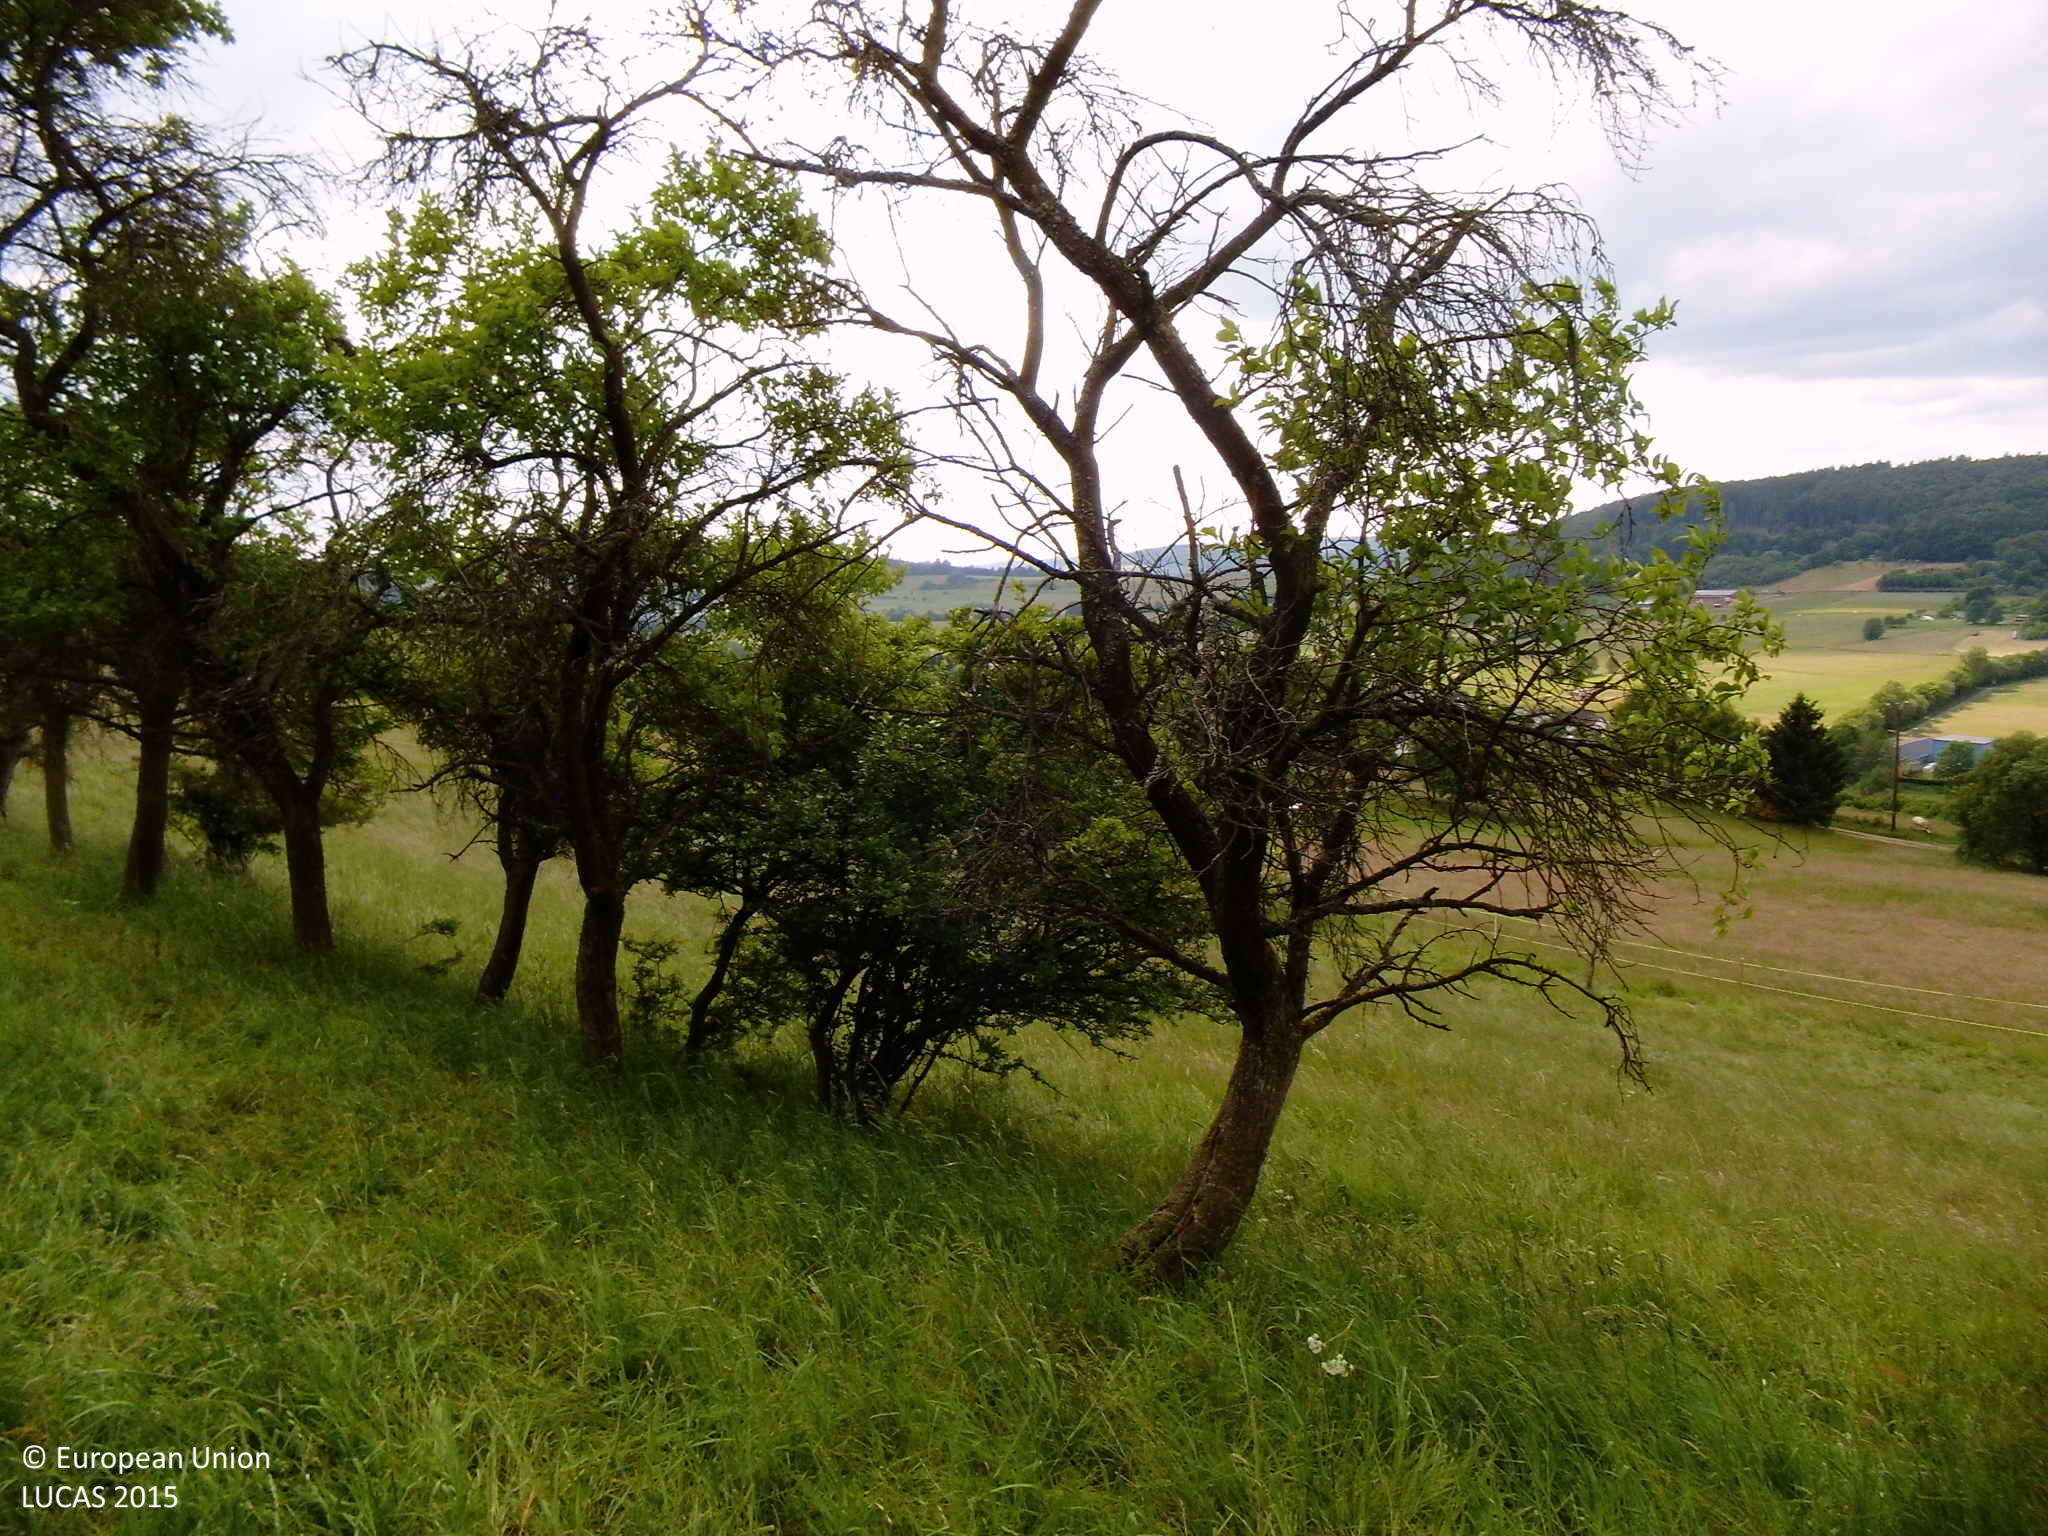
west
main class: Grassland
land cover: Grassland without tree/shrub cover
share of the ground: > 75 %
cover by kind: herbaceous plants 100 %
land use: Agriculture (excluding fallow land and kitchen gardens)
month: June
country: DE
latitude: 50.8391
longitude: 8.4525
